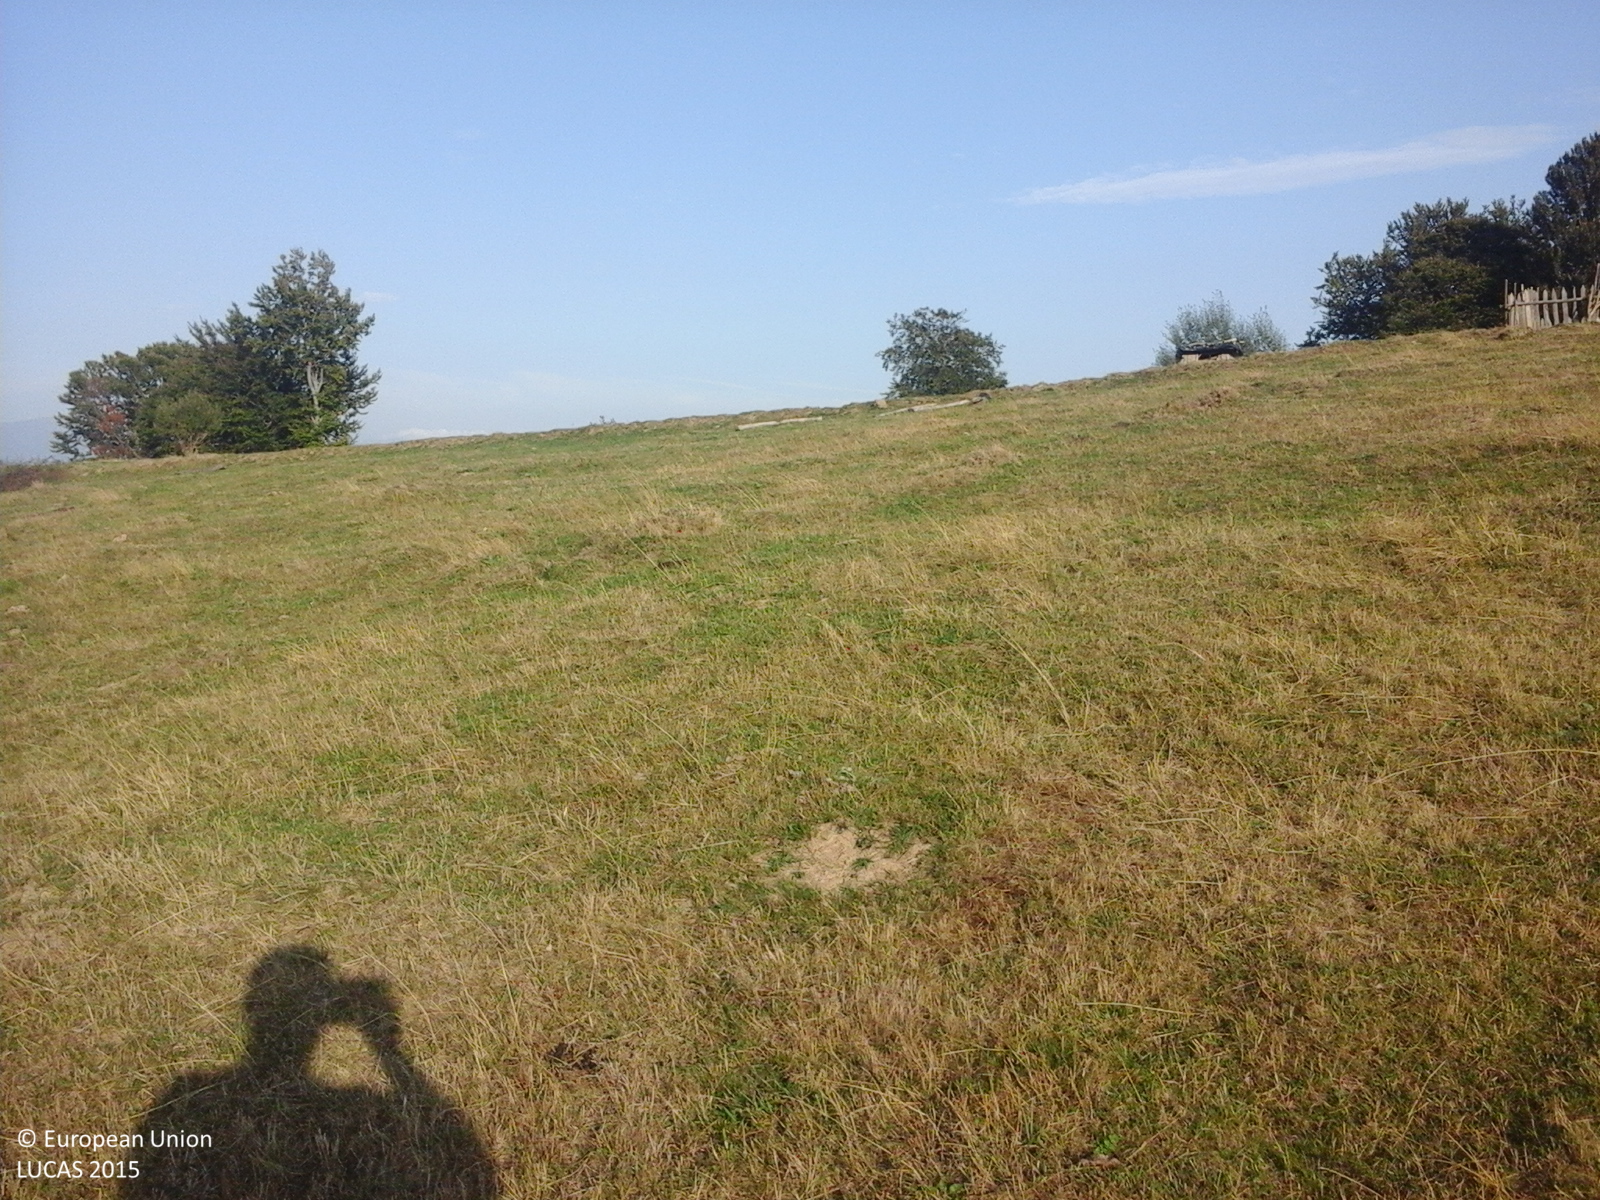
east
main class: Grassland
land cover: Grassland without tree/shrub cover
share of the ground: > 75 %
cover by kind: herbaceous plants 100 %
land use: Agriculture (excluding fallow land and kitchen gardens)
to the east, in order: Grassland without tree/shrub cover; Ditches and canals; Grassland without tree/shrub cover; Rock outcrops; Grassland without tree/shrub cover; Grassland with sparse tree/shrub cover; Broadleaved woodland
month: September
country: RO
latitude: 45.1596
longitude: 22.1876
